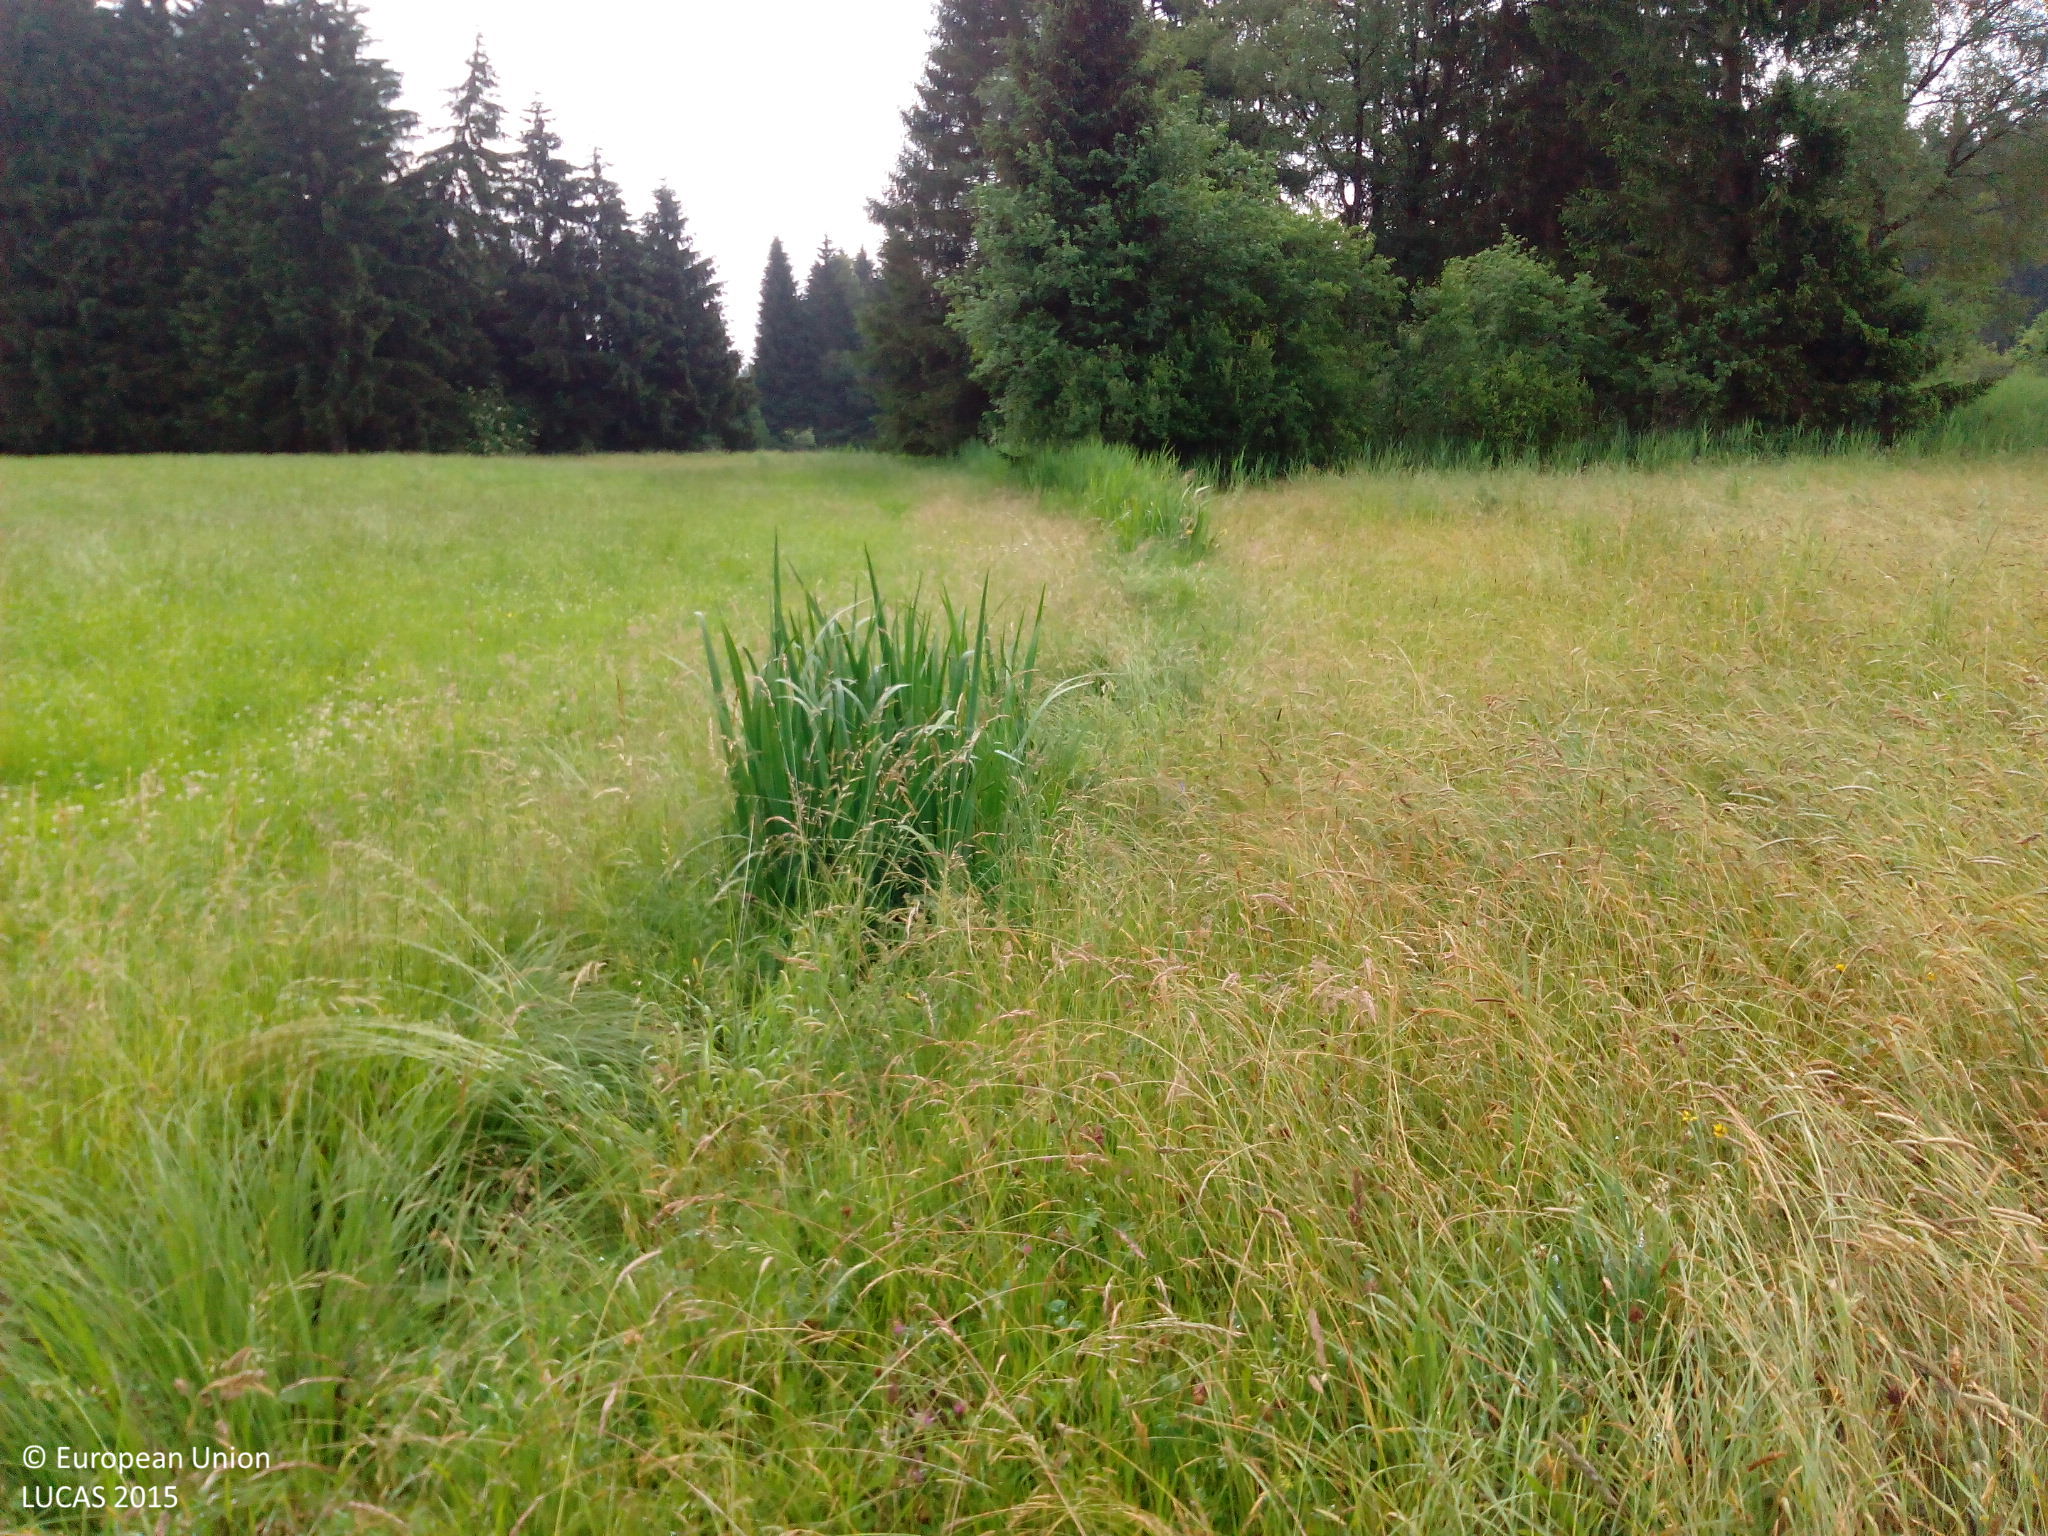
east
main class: Grassland
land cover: Grassland without tree/shrub cover
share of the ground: > 75 %
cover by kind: herbaceous plants 100 %
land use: Agriculture (excluding fallow land and kitchen gardens)
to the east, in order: Grassland without tree/shrub cover; Ditches and canals; Grassland without tree/shrub cover; Inland marshes; Spruce dominated coniferous woodland; Grassland without tree/shrub cover; Single bushes/trees; Grassland without tree/shrub cover; Single bushes/trees; Grassland without tree/shrub cover; Tracks; Grassland without tree/shrub cover
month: June
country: DE
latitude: 47.6296
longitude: 9.9335
